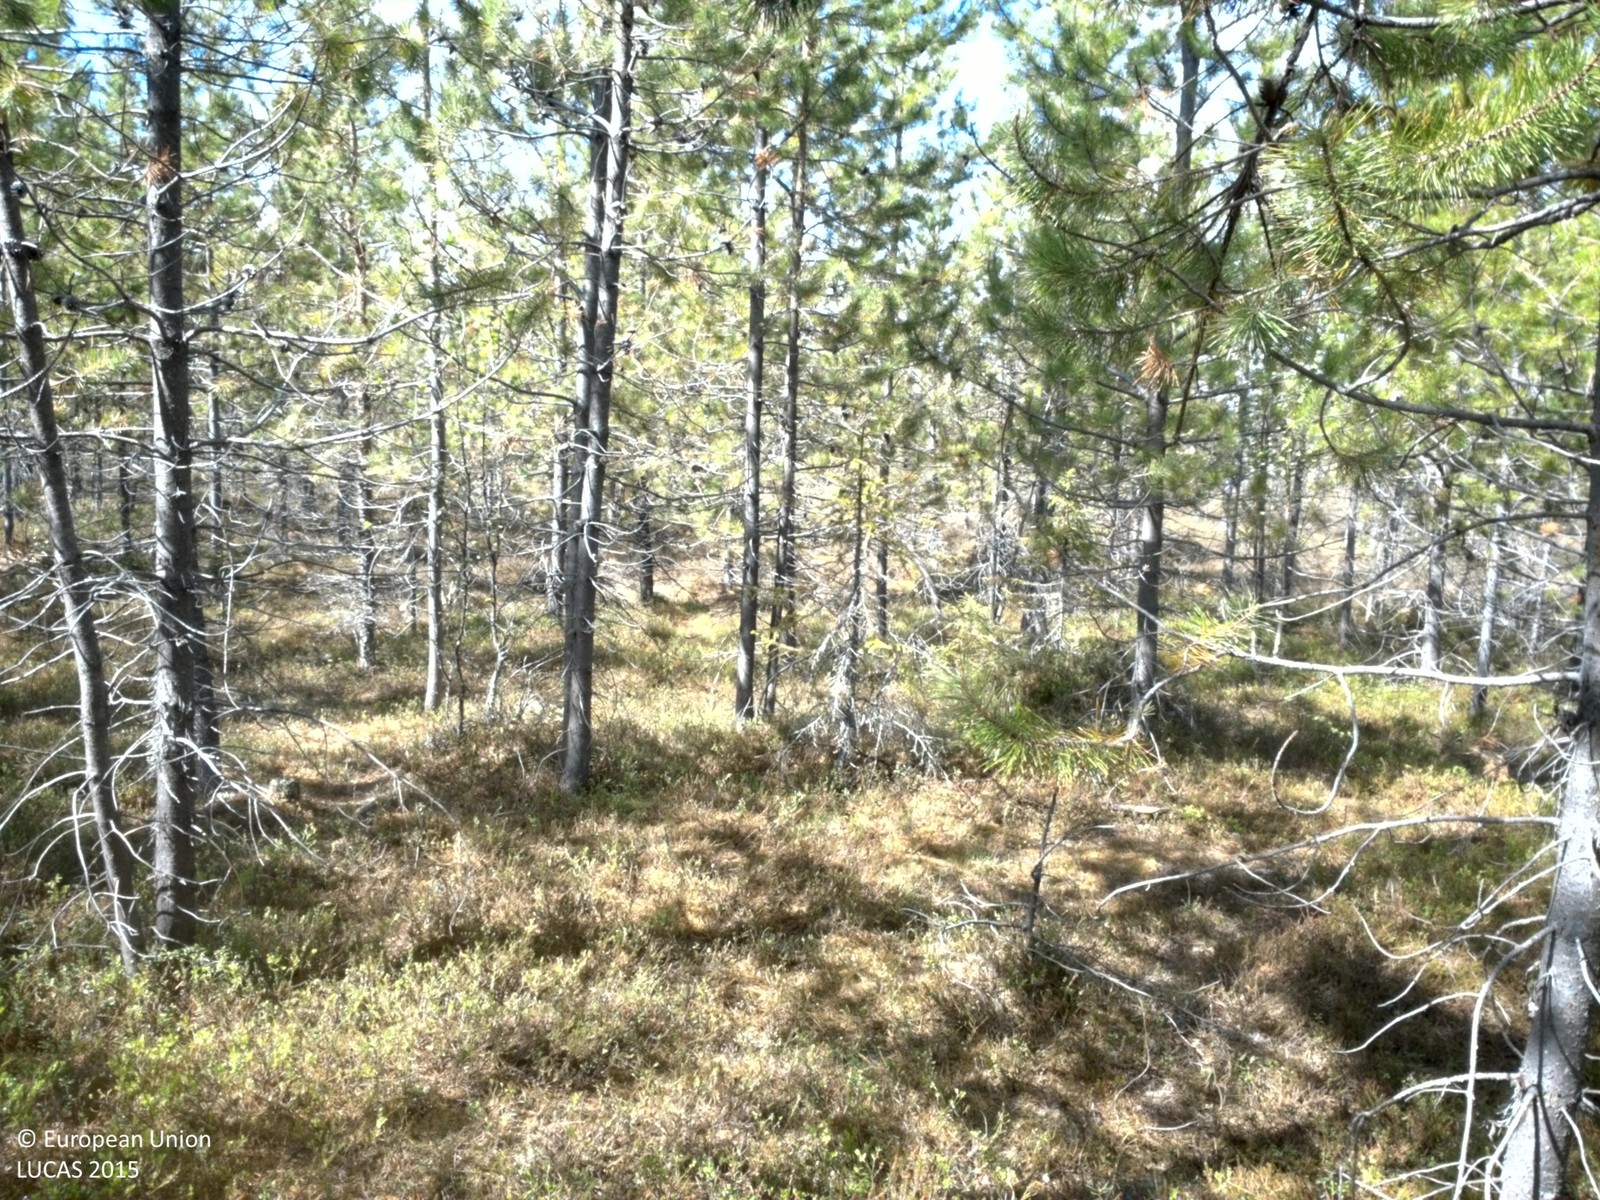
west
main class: Woodland
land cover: Pine dominated coniferous woodland
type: exotic forest
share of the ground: > 75 %
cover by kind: coniferous forest trees 75 %, shrubs 25 %
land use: Forestry
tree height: > 5 m
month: June
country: SE
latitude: 65.9757
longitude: 19.7541
